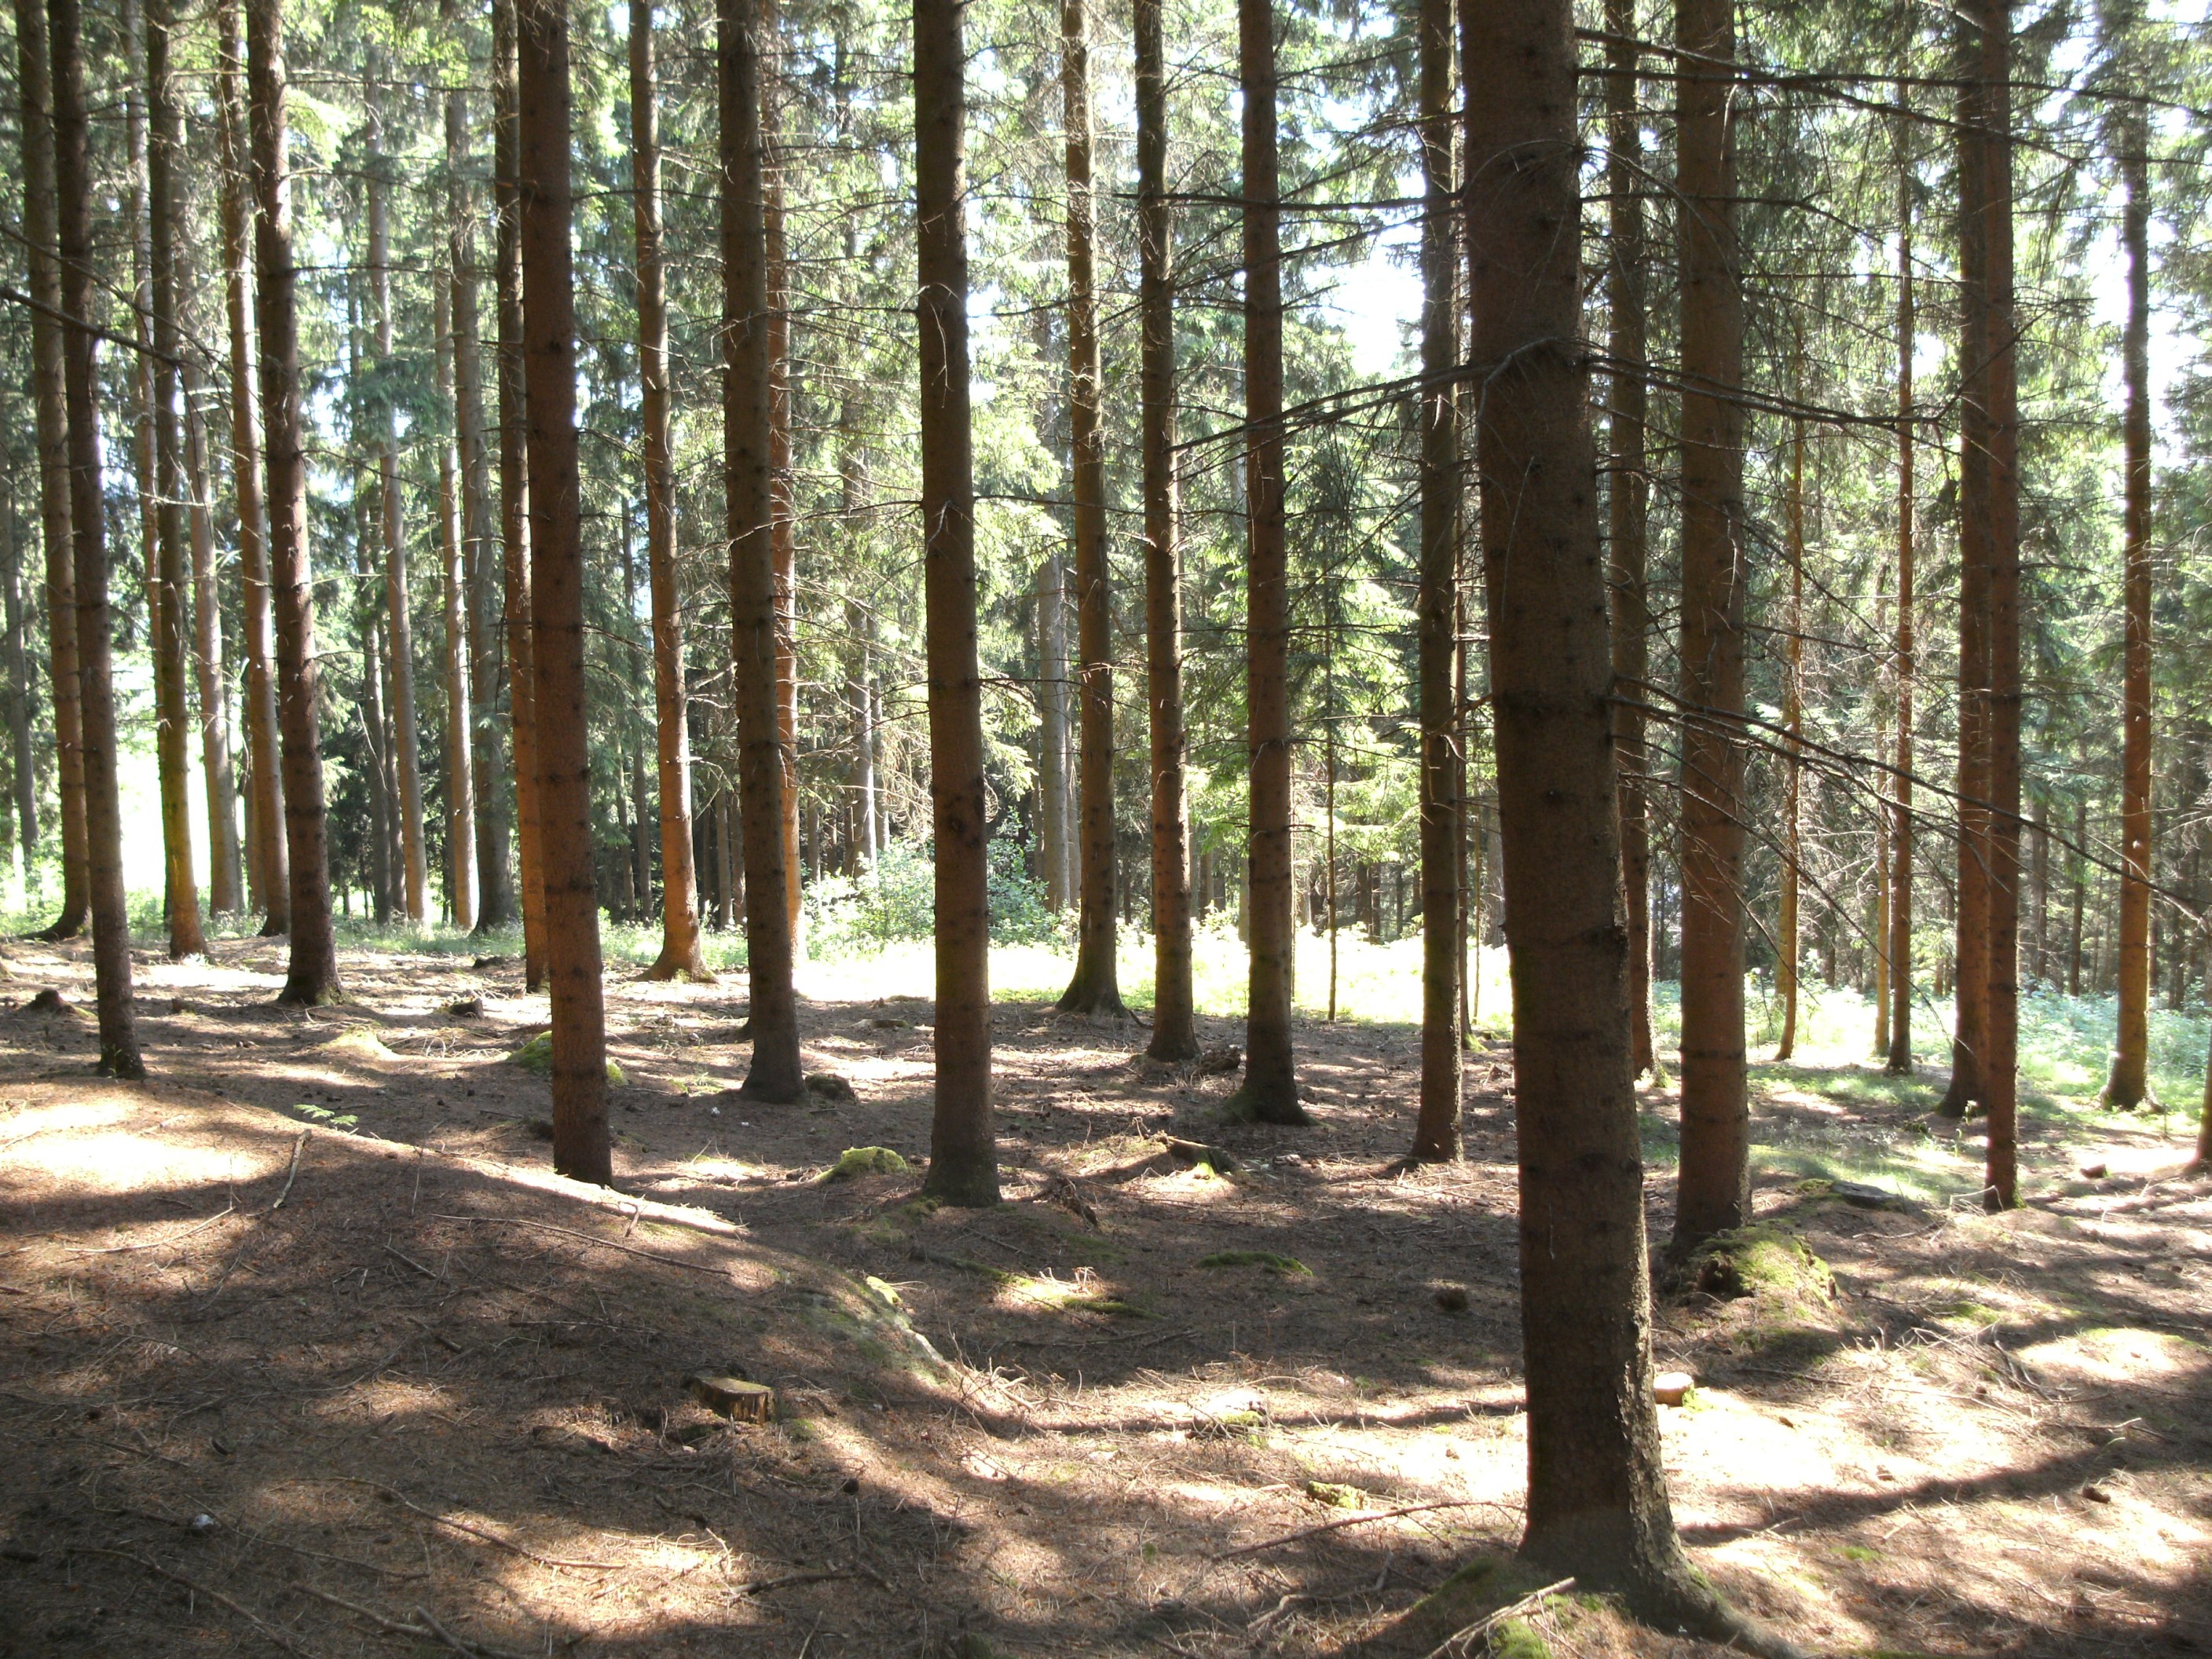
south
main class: Woodland
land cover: Spruce dominated coniferous woodland
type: hemiboreal forest and nemoral coniferous forest and mixed broadleaved-coniferous forest
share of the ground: > 75 %
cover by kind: coniferous forest trees 90 %, unconsolidated bare surface 10 %
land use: Forestry
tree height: > 5 m
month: June
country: AT
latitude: 48.4327
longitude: 14.1765
